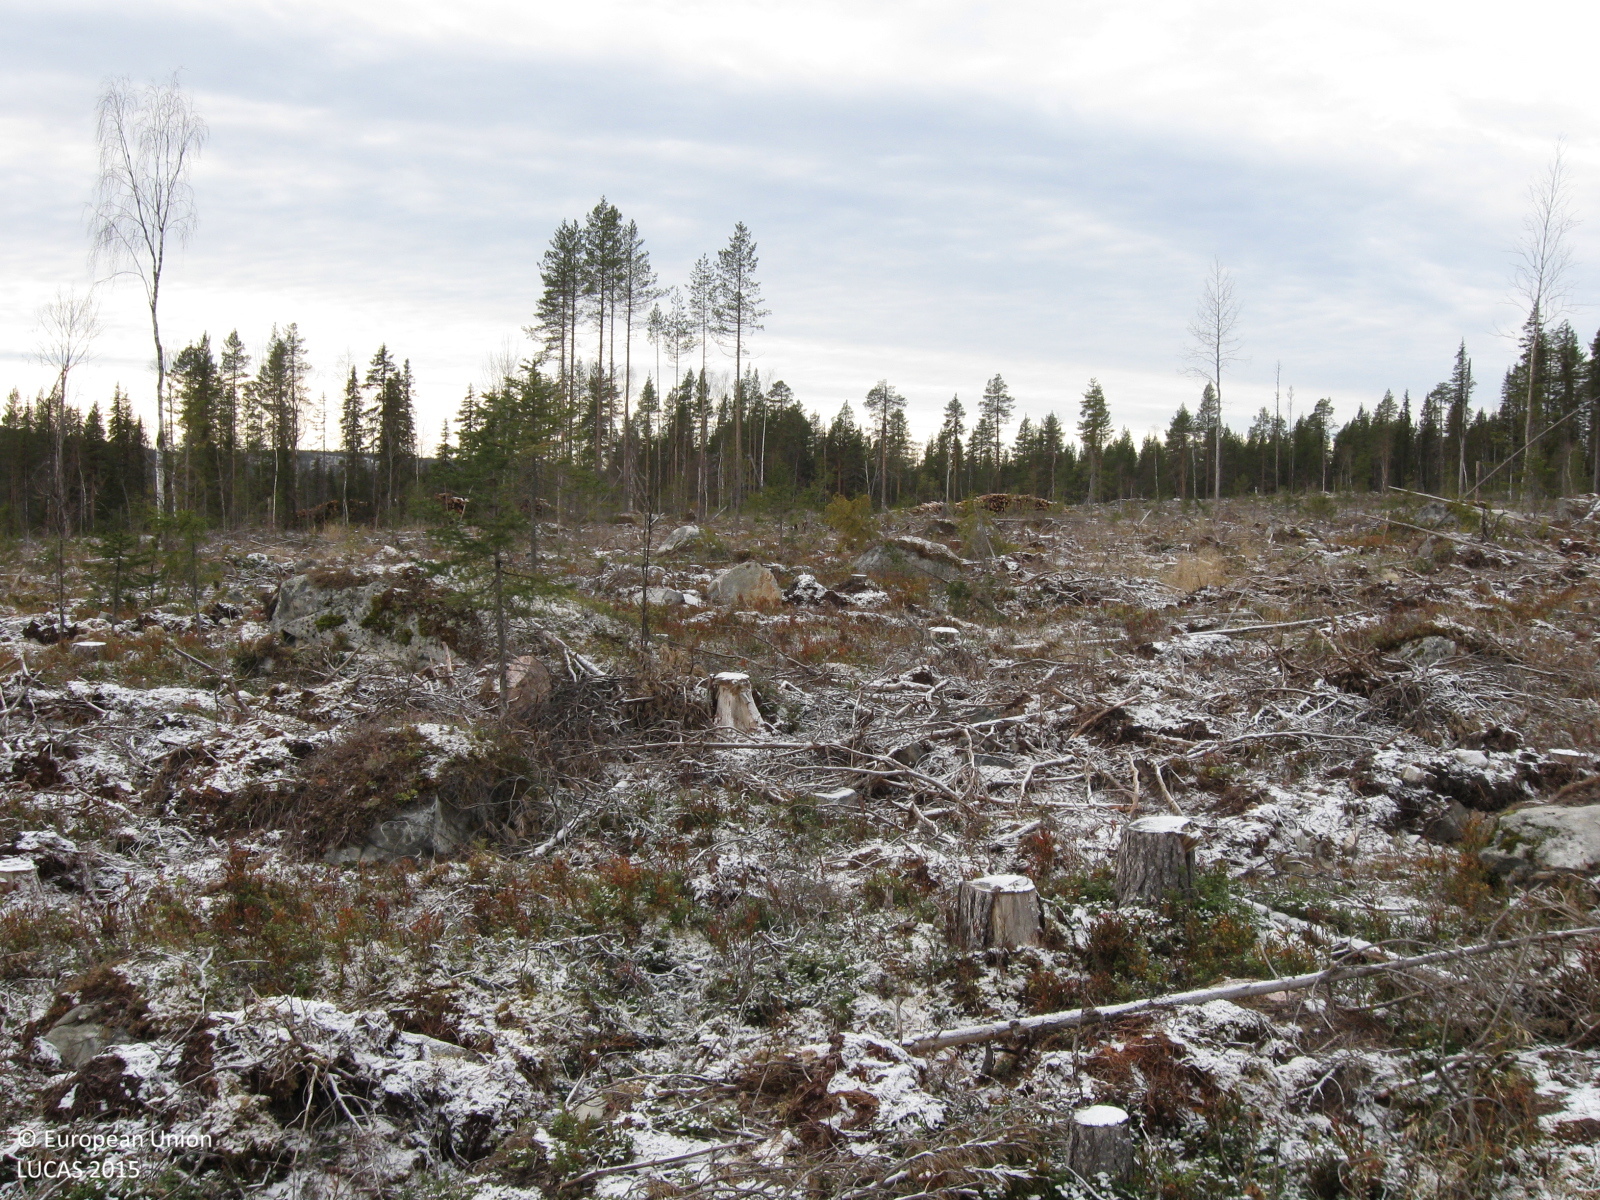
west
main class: Shrubland
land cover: Shrubland with sparse tree cover
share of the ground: 25 - 50 %
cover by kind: shrubs 45 %, consolidated bare surface 15 %, herbaceous plants 10 %, lichens and mosses 10 %, coniferous forest trees 5 %, unconsolidated bare surface 5 %
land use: Forestry
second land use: Amenities, museums, leisure
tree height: < 5 m
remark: Clear cut
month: October
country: SE
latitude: 66.2125
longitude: 21.4973
